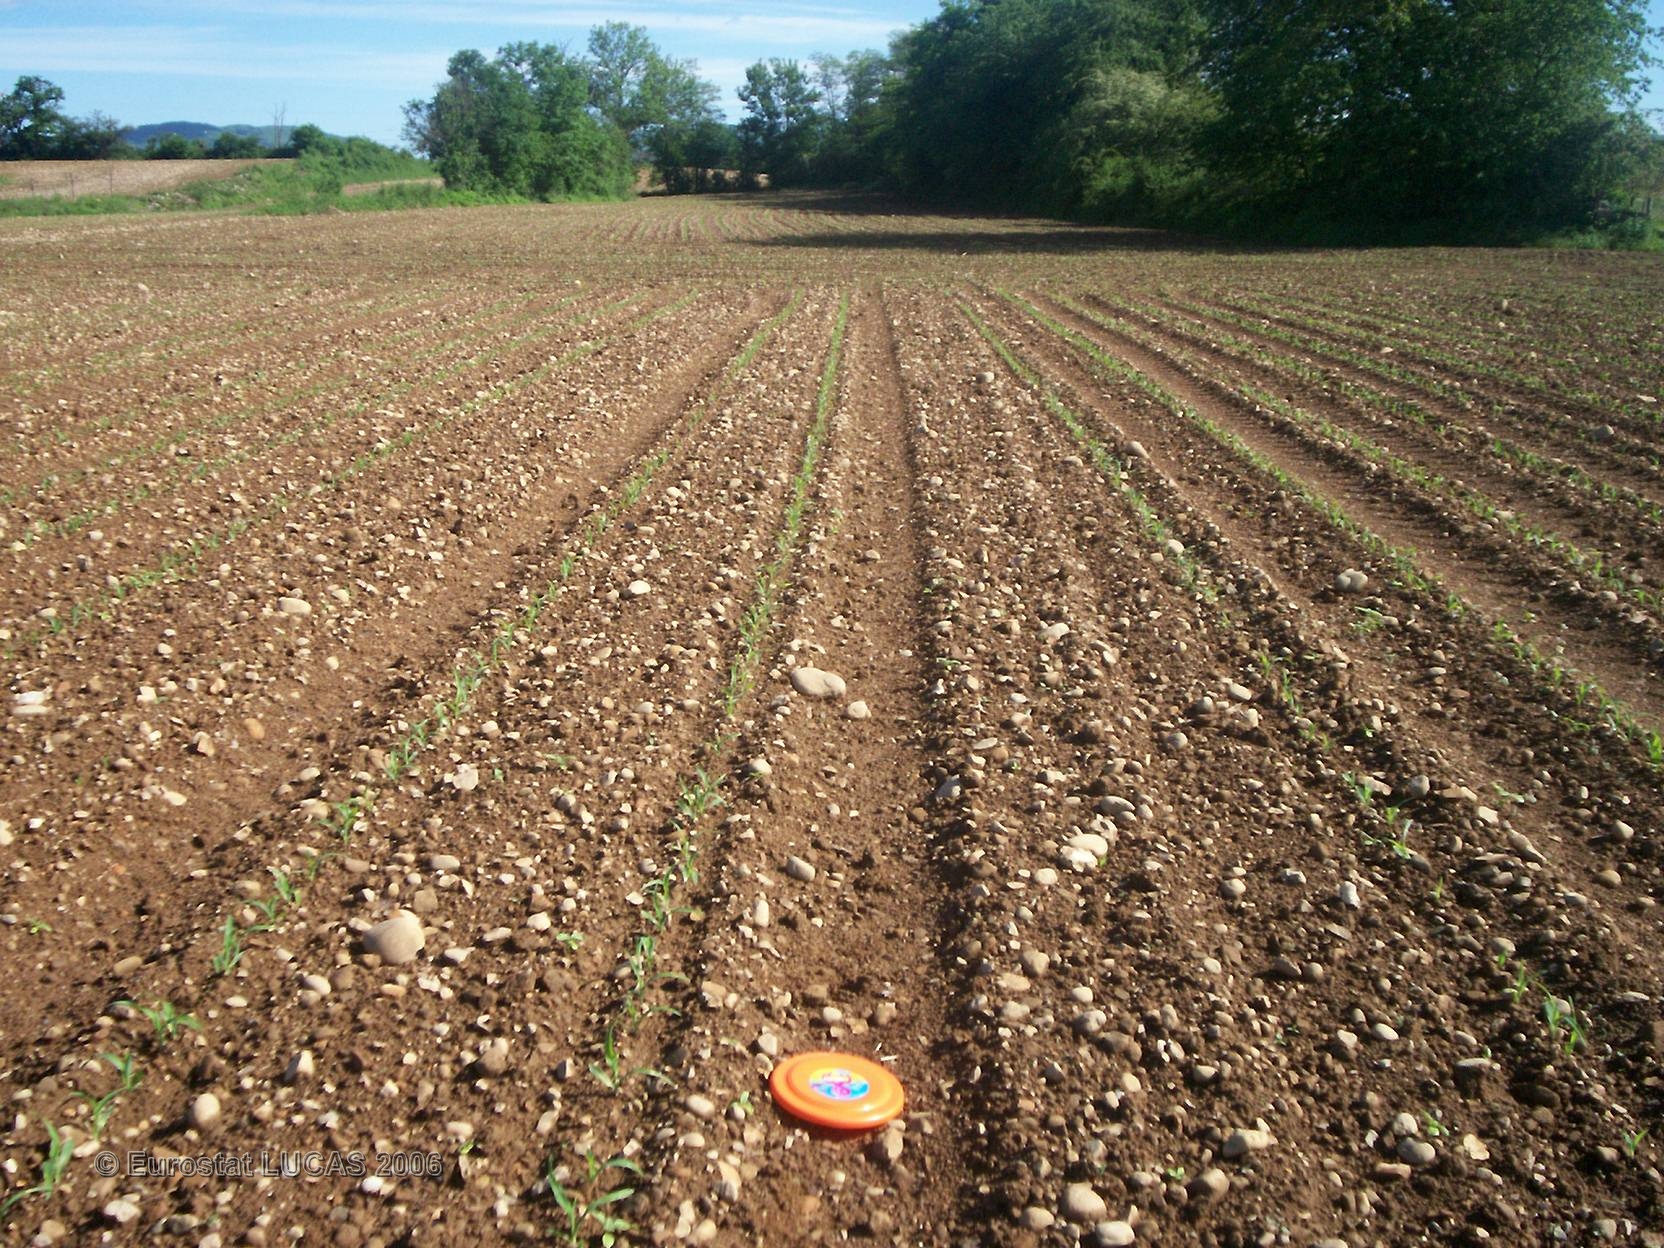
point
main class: Cropland
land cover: Maize
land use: Agriculture (excluding fallow land and kitchen gardens)
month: May
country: FR
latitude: 45.3510
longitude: 5.4227
